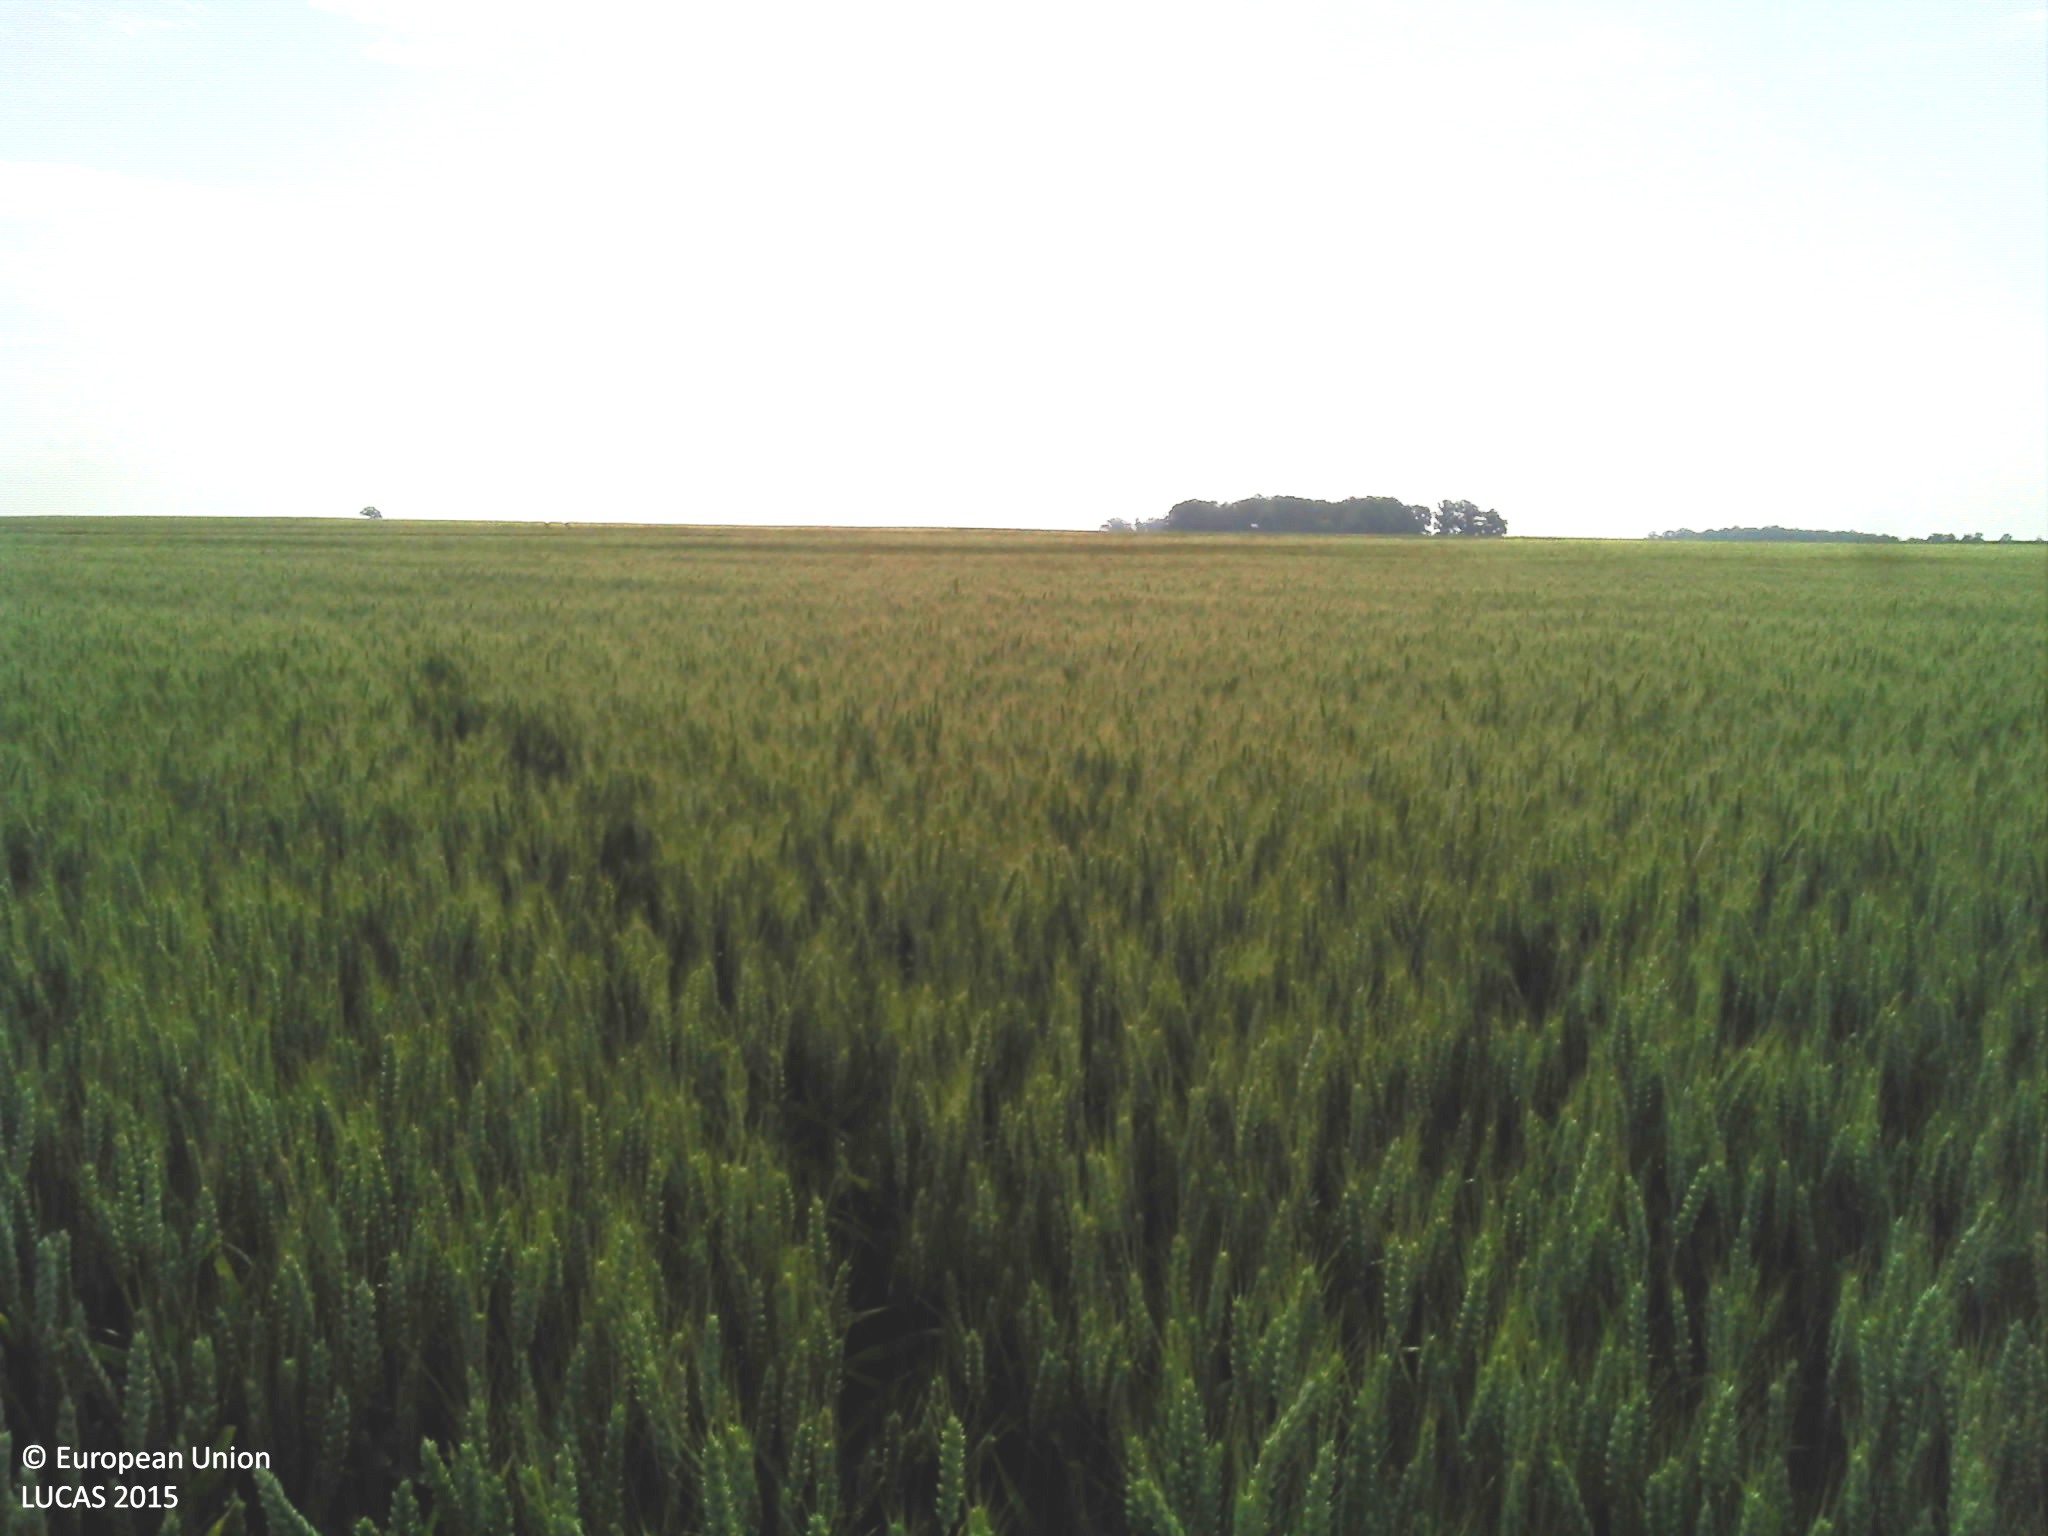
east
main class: Cropland
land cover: Common wheat
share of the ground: > 75 %
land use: Agriculture (excluding fallow land and kitchen gardens)
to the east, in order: Common wheat; Ditches and canals; Grass margins; Paved roads, cycling and walking lanes; Grass margins; Ditches and canals; Common wheat
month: June
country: FR
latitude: 48.2891
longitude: 1.4518
